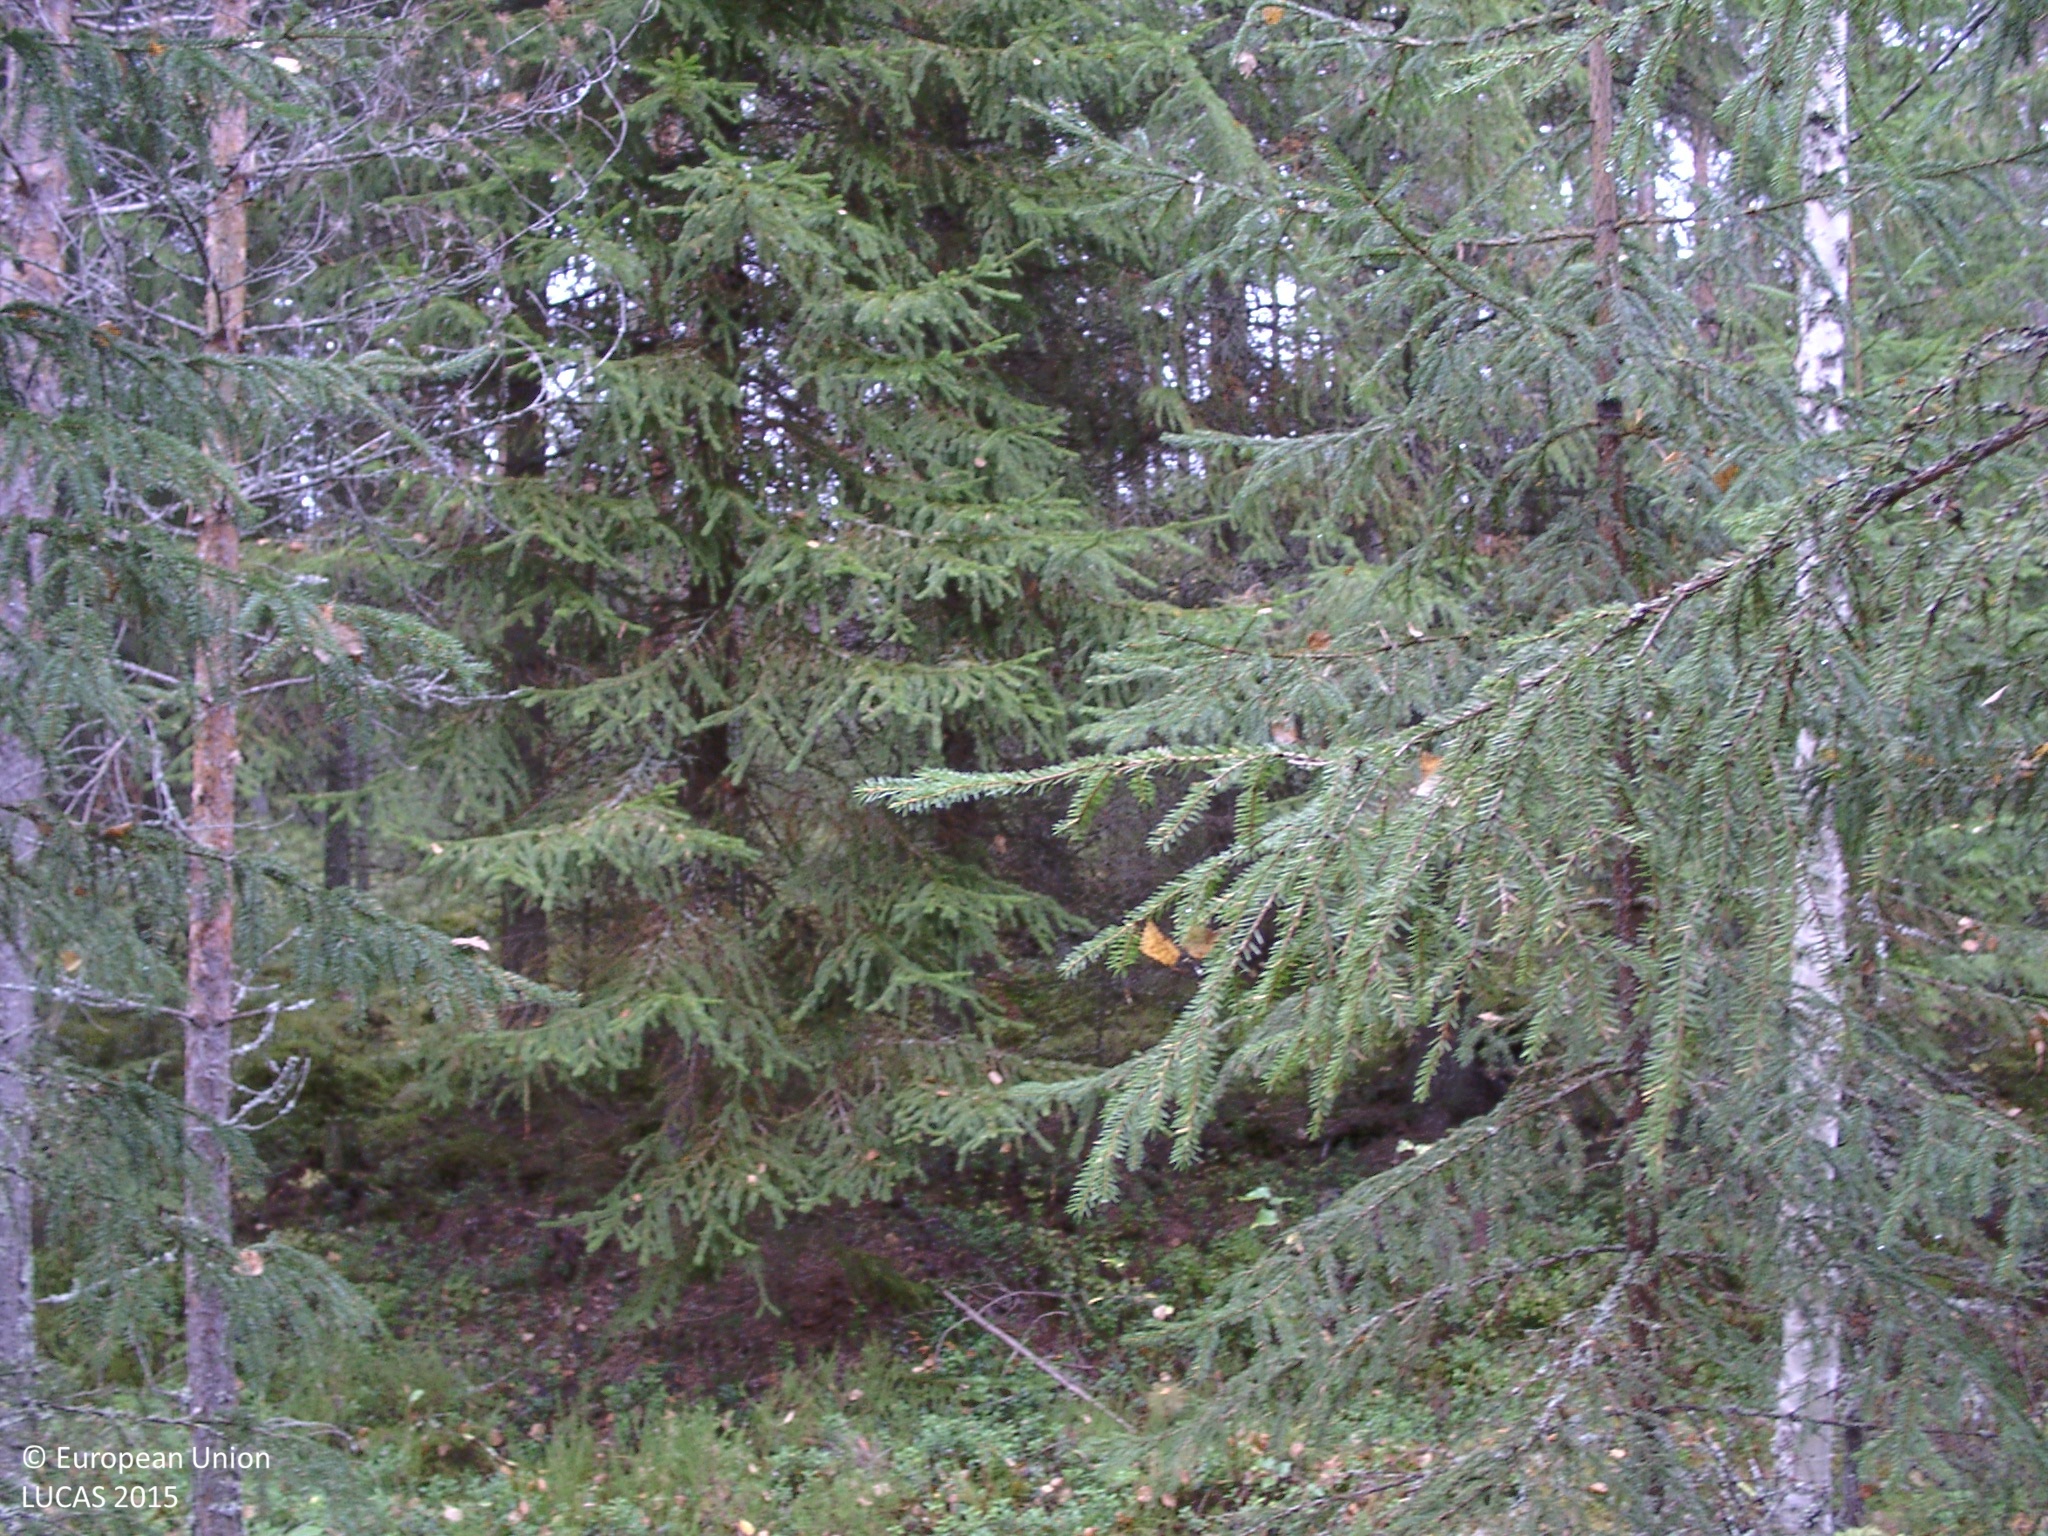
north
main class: Woodland
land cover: Other mixed woodland
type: boreal forest
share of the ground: 50 - 75 %
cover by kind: coniferous forest trees 45 %, broadleaved forest trees 25 %, shrubs 10 %, herbaceous plants 10 %, lichens and mosses 10 %
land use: Forestry
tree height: > 5 m
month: September
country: FI
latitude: 62.6831
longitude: 25.7217
